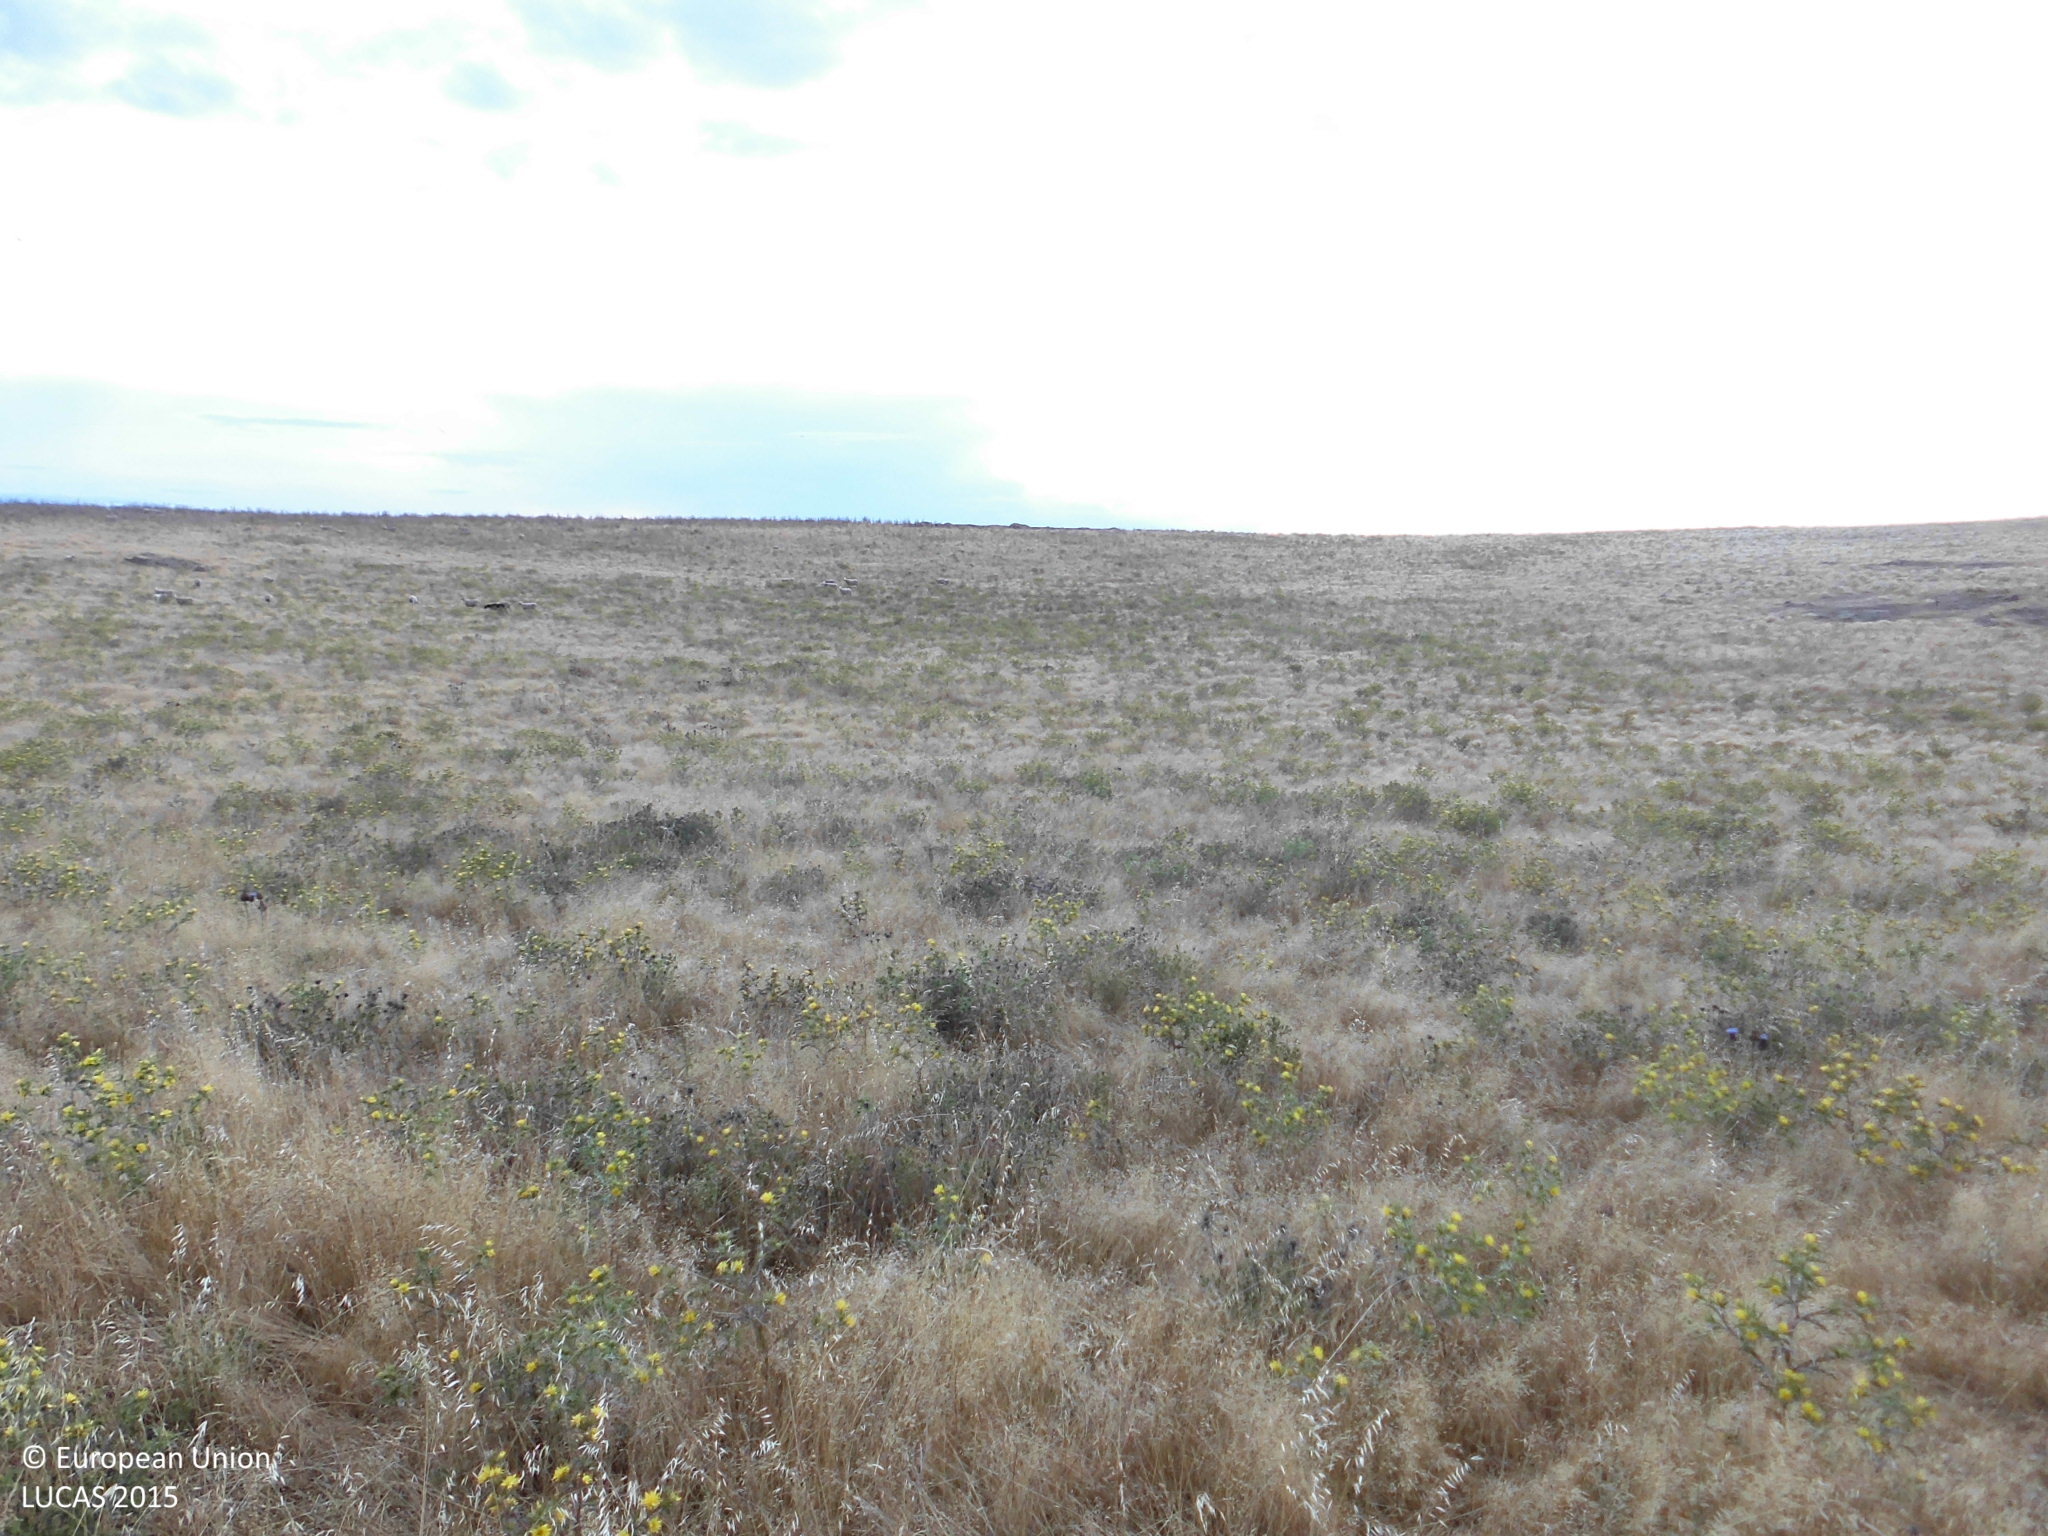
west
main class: Grassland
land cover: Grassland without tree/shrub cover
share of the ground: > 75 %
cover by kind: herbaceous plants 100 %
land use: Agriculture (excluding fallow land and kitchen gardens)
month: June
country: ES
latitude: 39.3800
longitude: -5.9272
